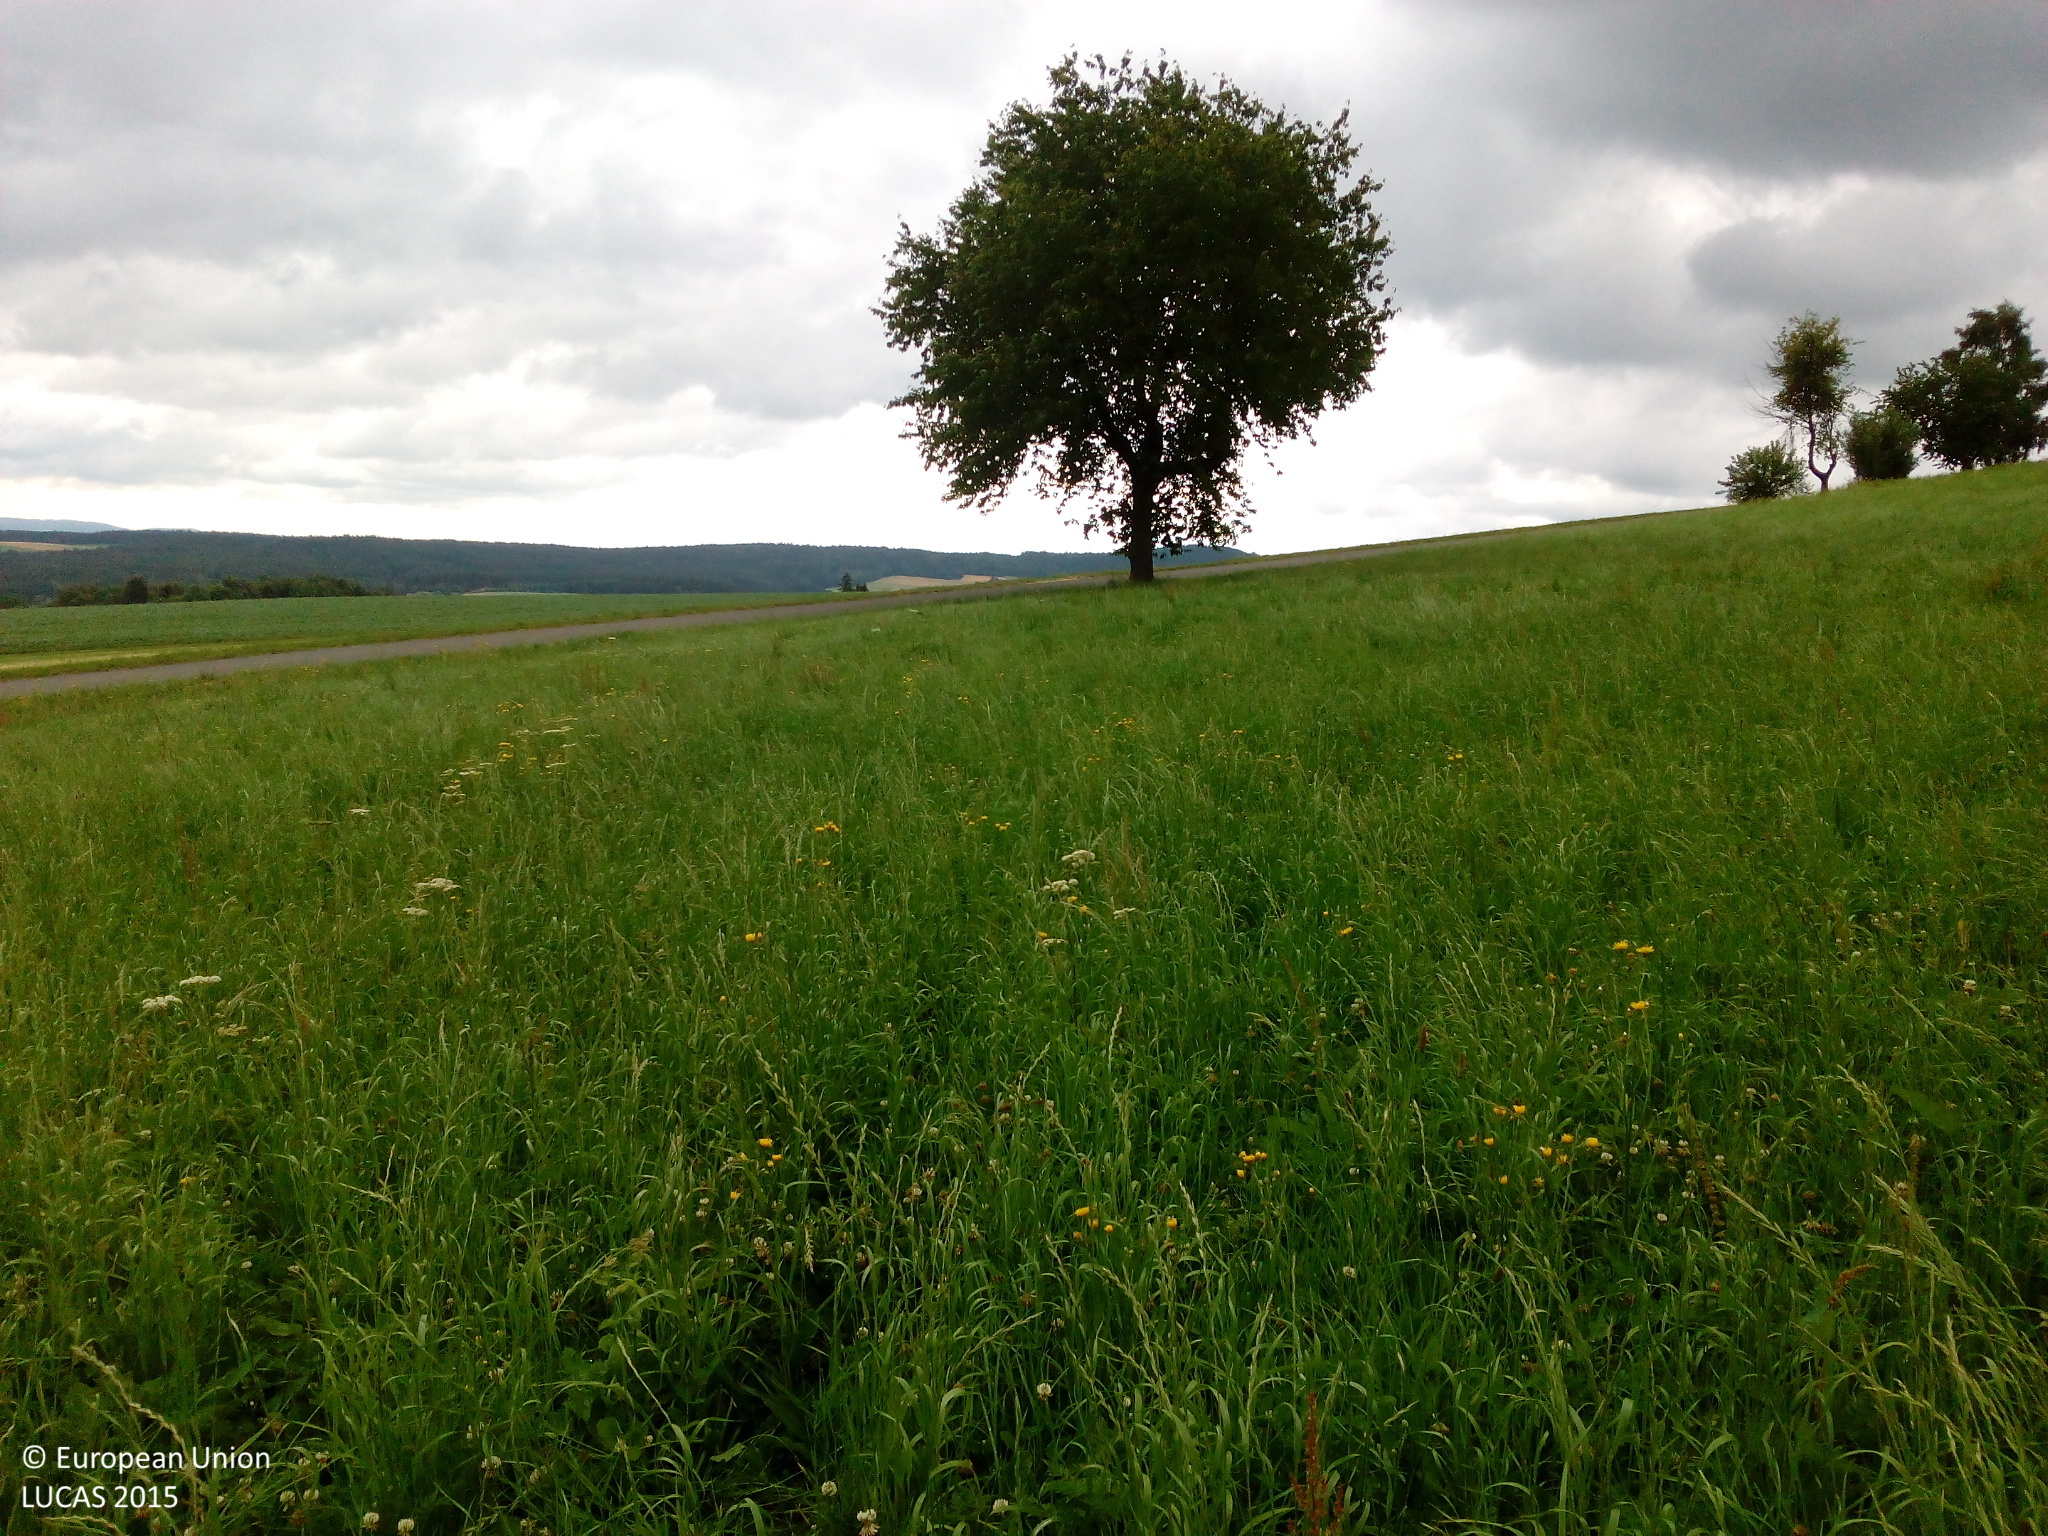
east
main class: Grassland
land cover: Grassland without tree/shrub cover
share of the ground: > 75 %
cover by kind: herbaceous plants 100 %
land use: Agriculture (excluding fallow land and kitchen gardens)
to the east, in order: Grassland without tree/shrub cover; Single bushes/trees; Grass margins; Paved roads, cycling and walking lanes; Grassland without tree/shrub cover; Tracks
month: July
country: DE
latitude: 49.5469
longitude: 12.4183
